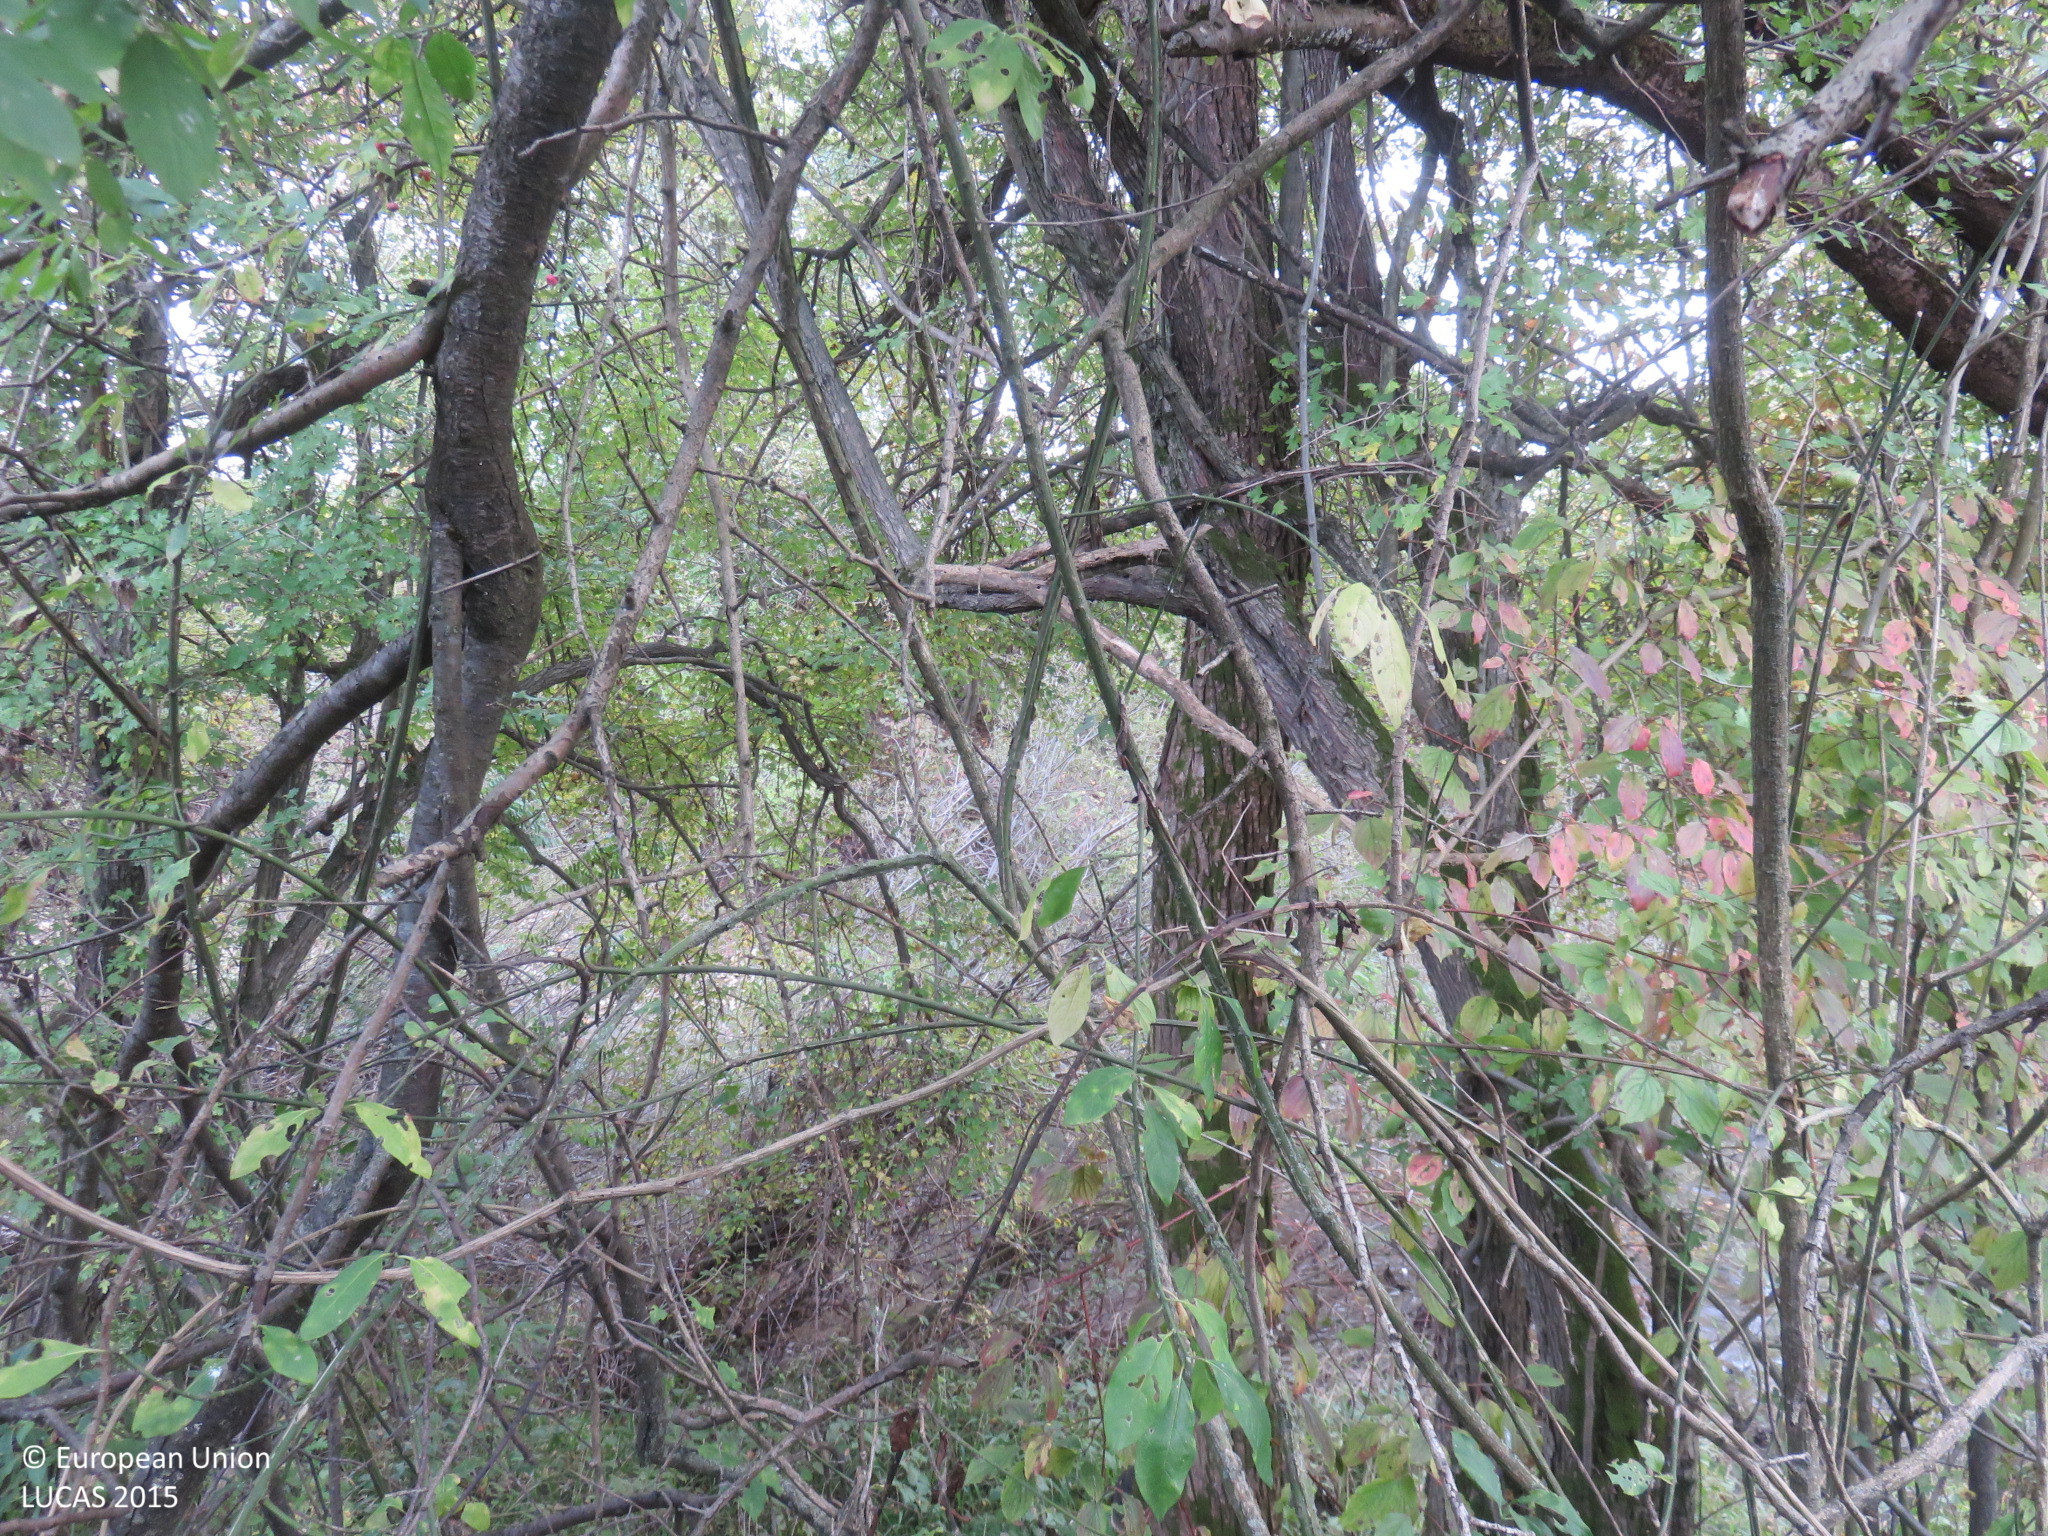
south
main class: Woodland
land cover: Broadleaved woodland
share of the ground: 50 - 75 %
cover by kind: broadleaved forest trees 60 %, shrubs 40 %
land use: Semi-natural and natural areas not in use
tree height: < 5 m
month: October
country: BG
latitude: 42.9580
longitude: 25.1336
